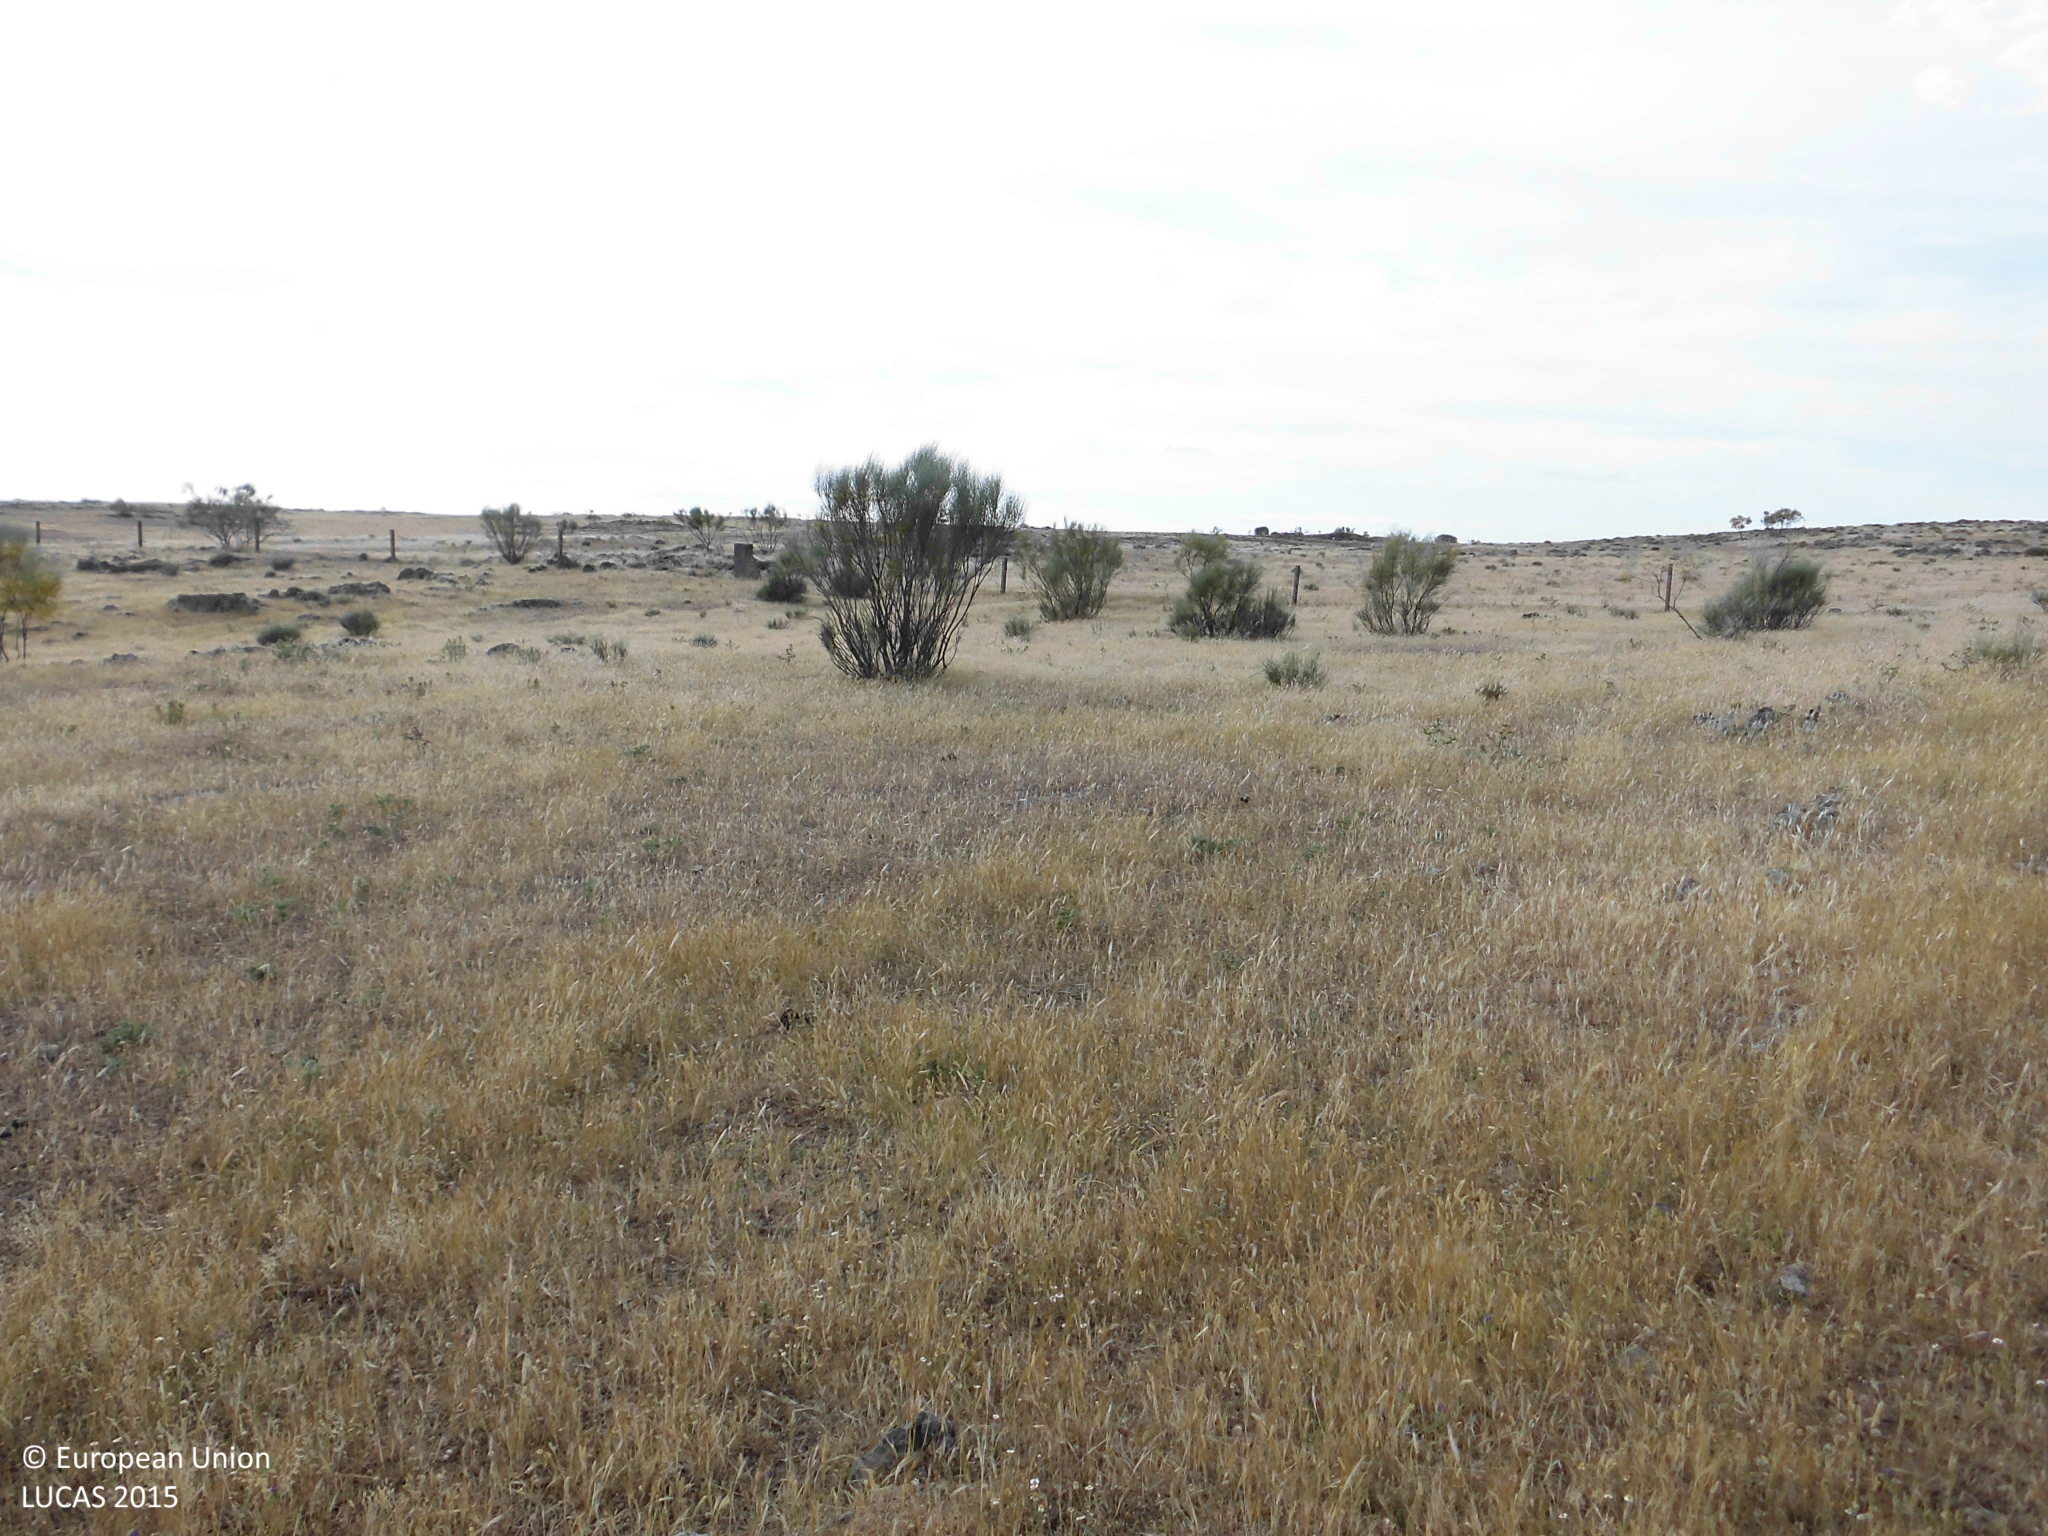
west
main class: Grassland
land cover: Grassland without tree/shrub cover
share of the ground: > 75 %
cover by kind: herbaceous plants 95 %, shrubs 5 %
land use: Agriculture (excluding fallow land and kitchen gardens)
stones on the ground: < 10 %
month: May
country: ES
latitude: 39.5592
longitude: -6.0667
